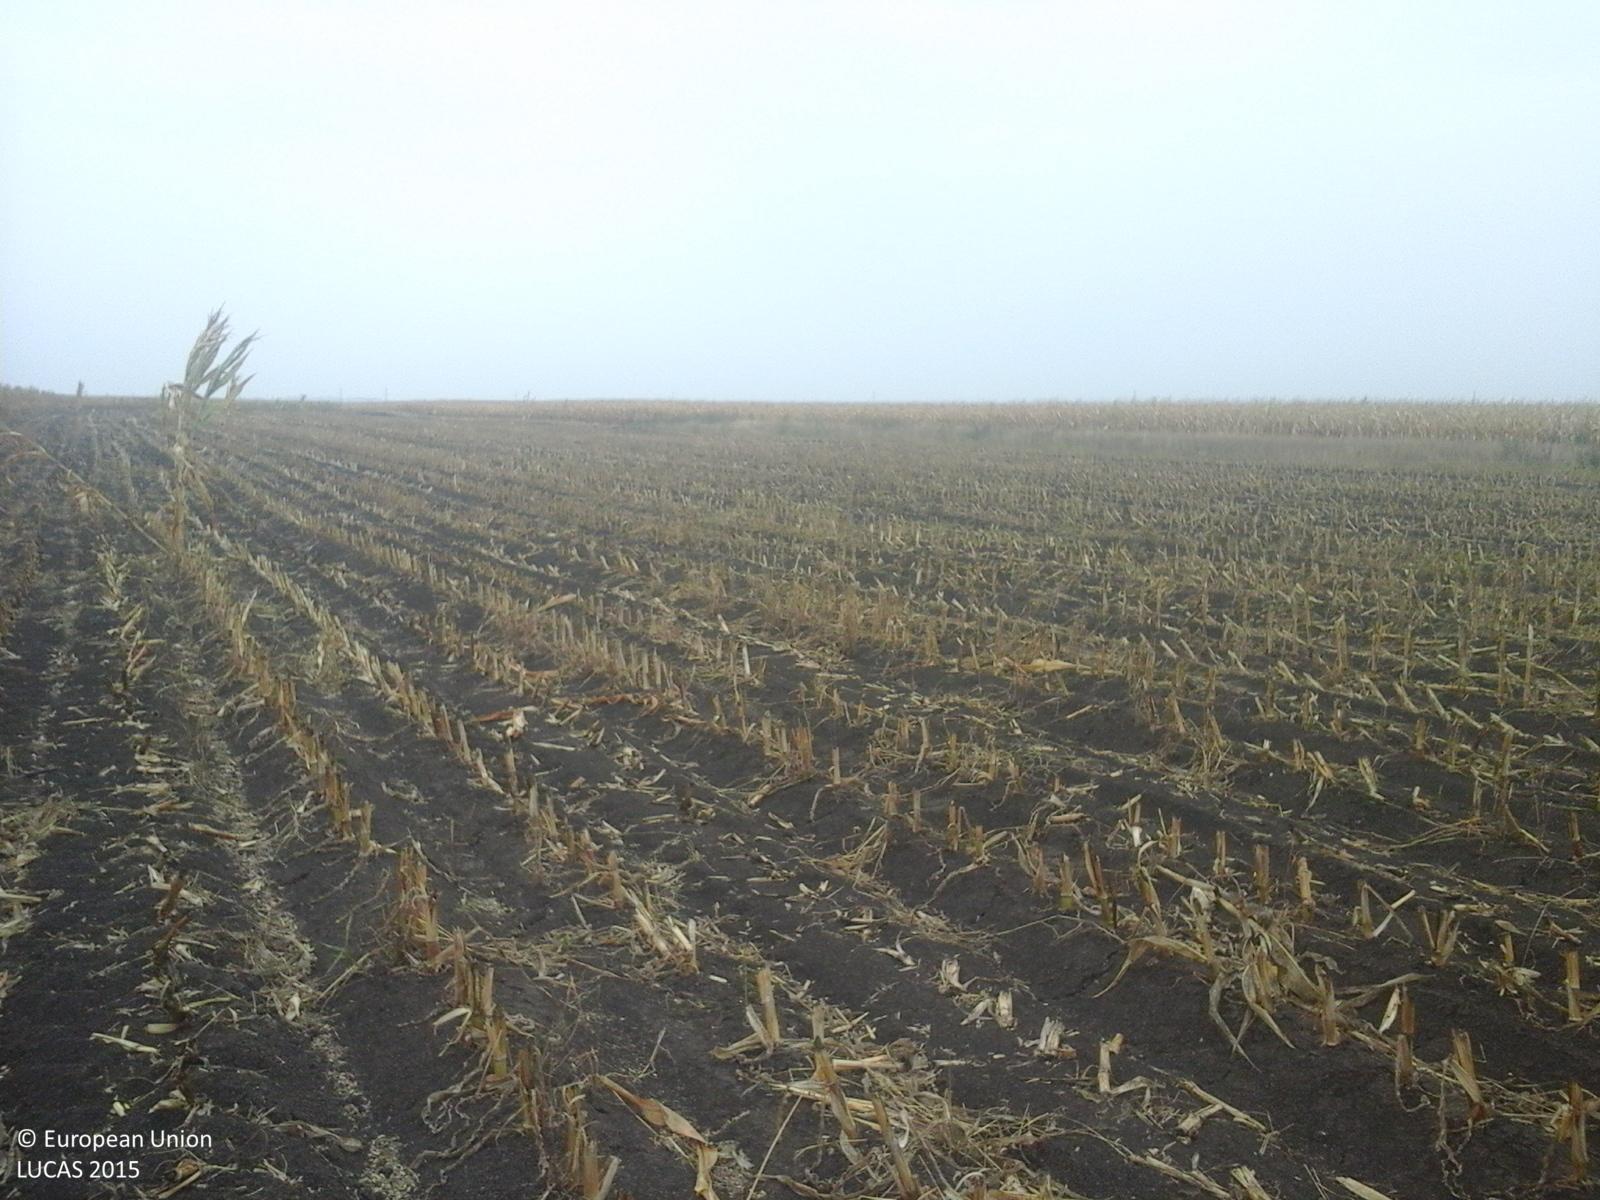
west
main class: Cropland
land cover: Maize
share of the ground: > 75 %
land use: Agriculture (excluding fallow land and kitchen gardens)
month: September
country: RO
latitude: 47.7007
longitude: 22.5722
